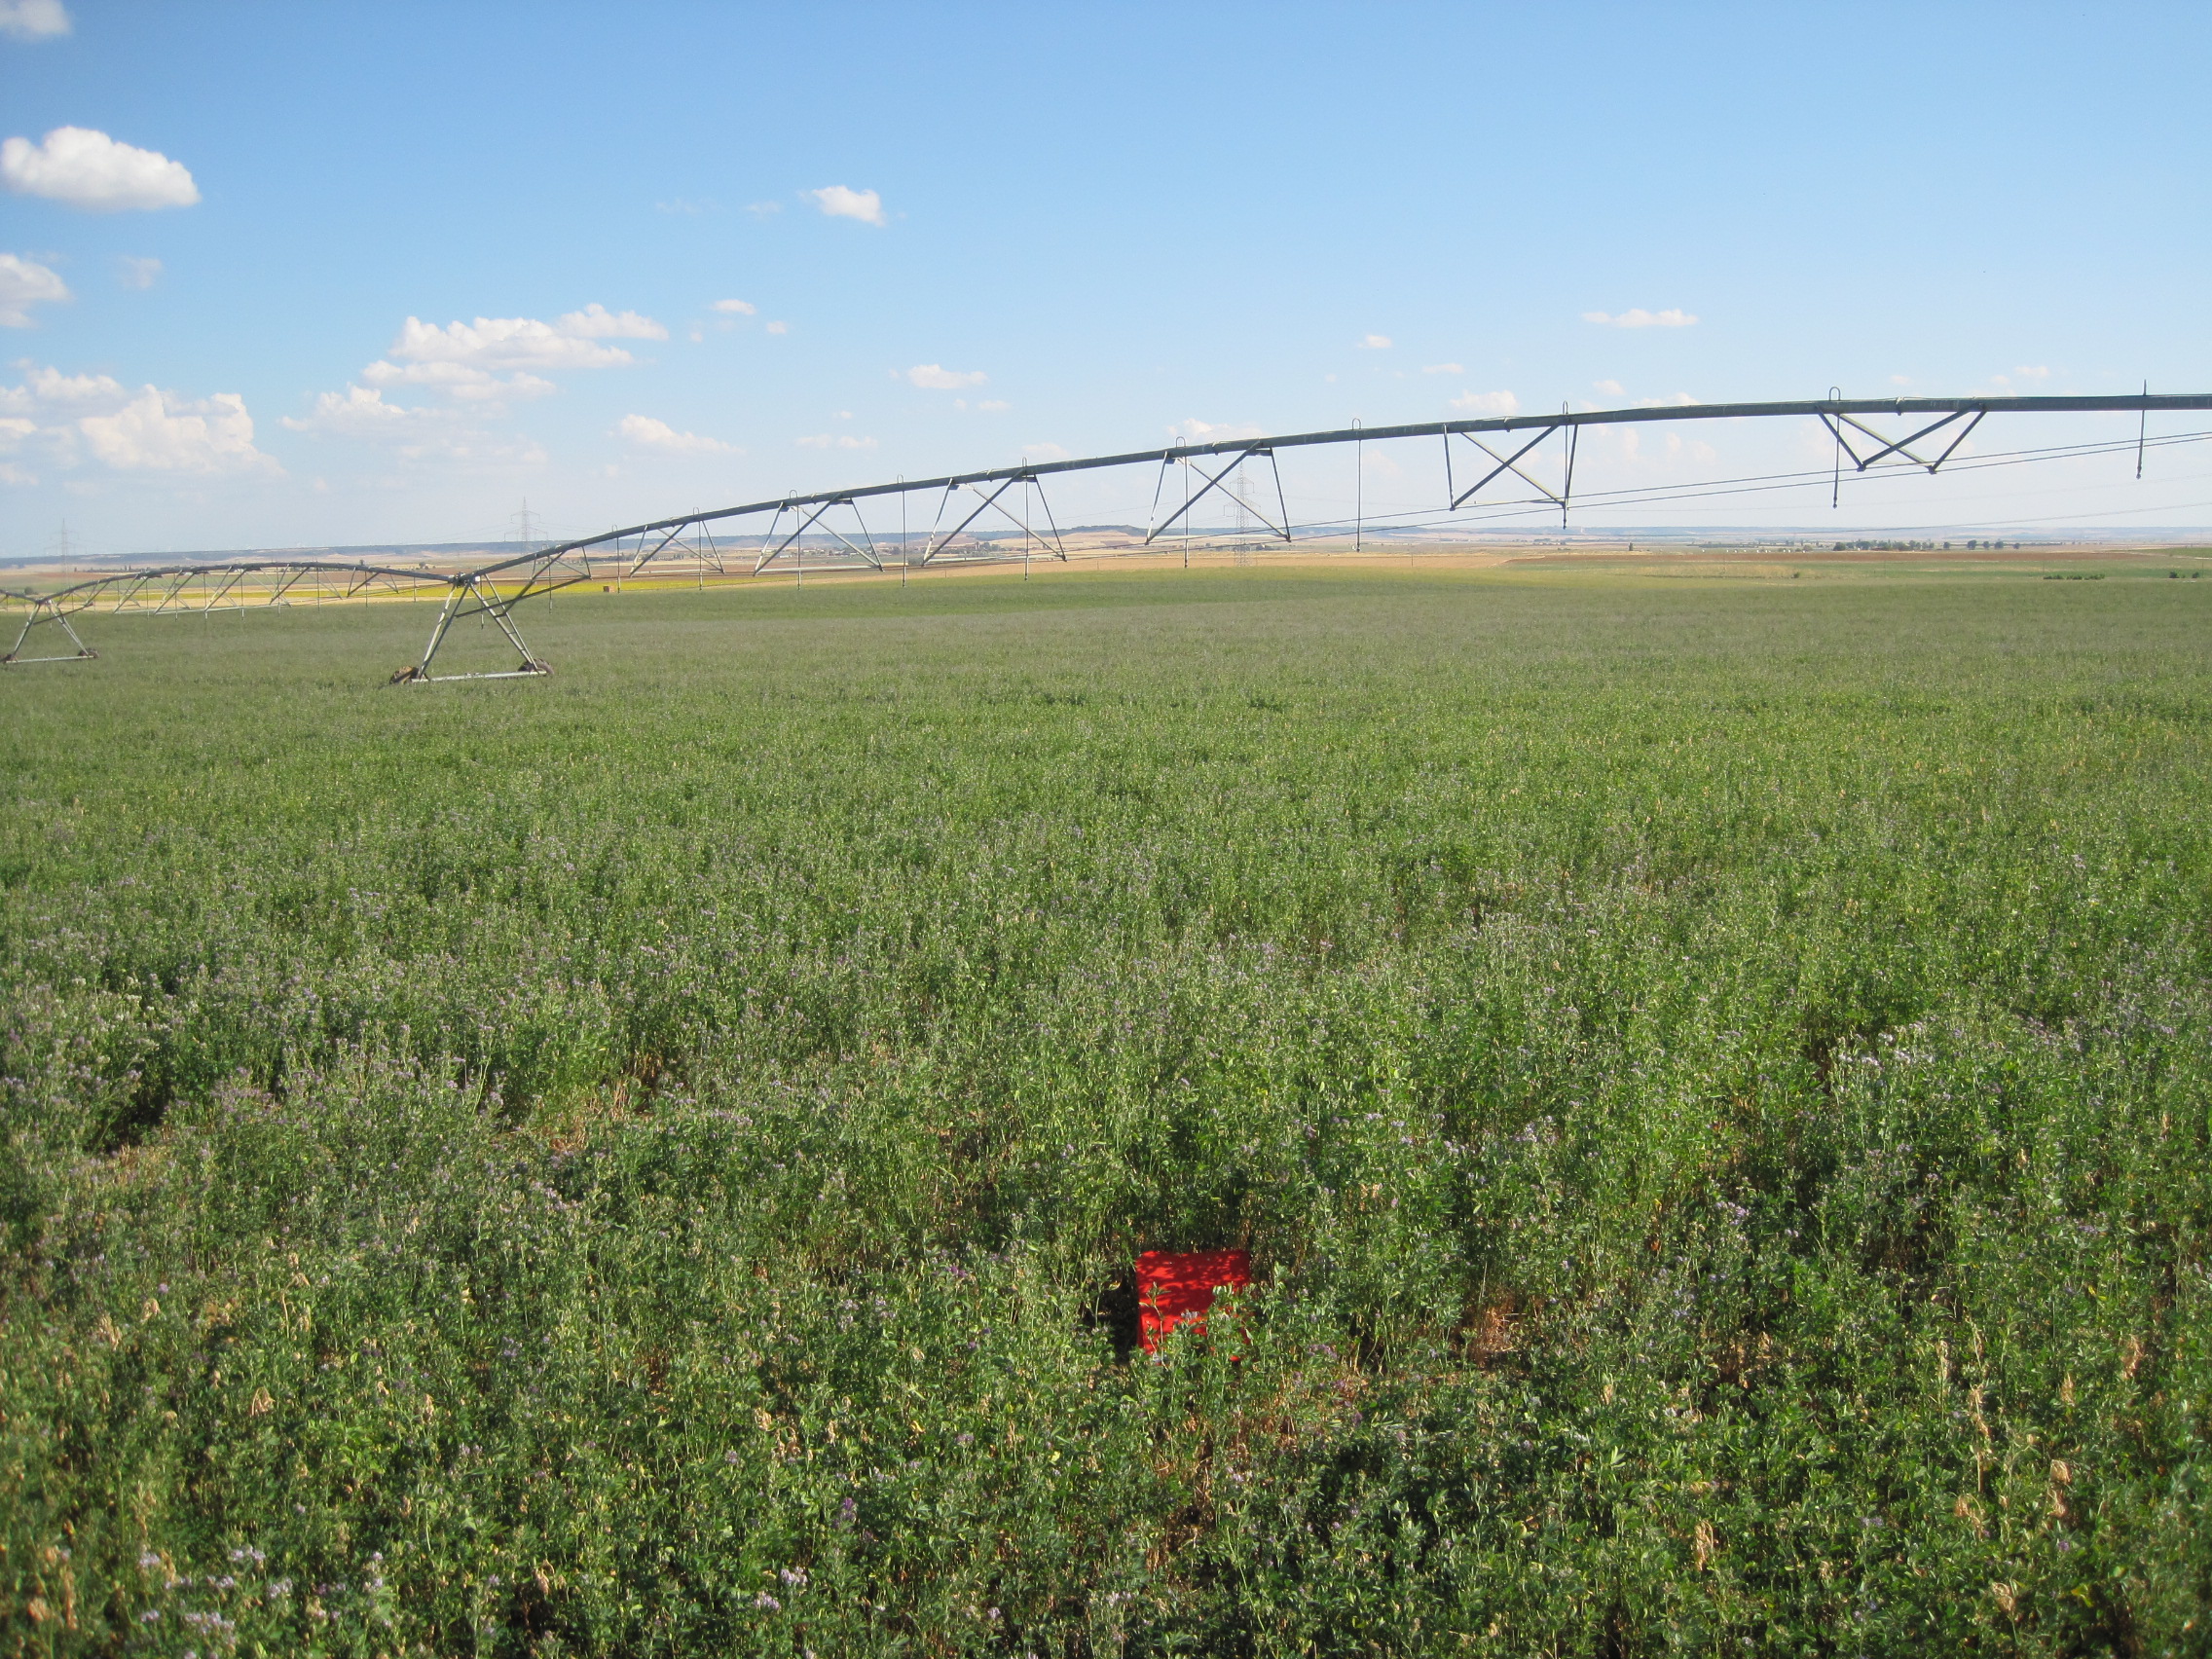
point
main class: Cropland
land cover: Lucerne
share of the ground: > 75 %
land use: Agriculture (excluding fallow land and kitchen gardens)
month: July
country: ES
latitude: 41.9049
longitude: -5.1855
